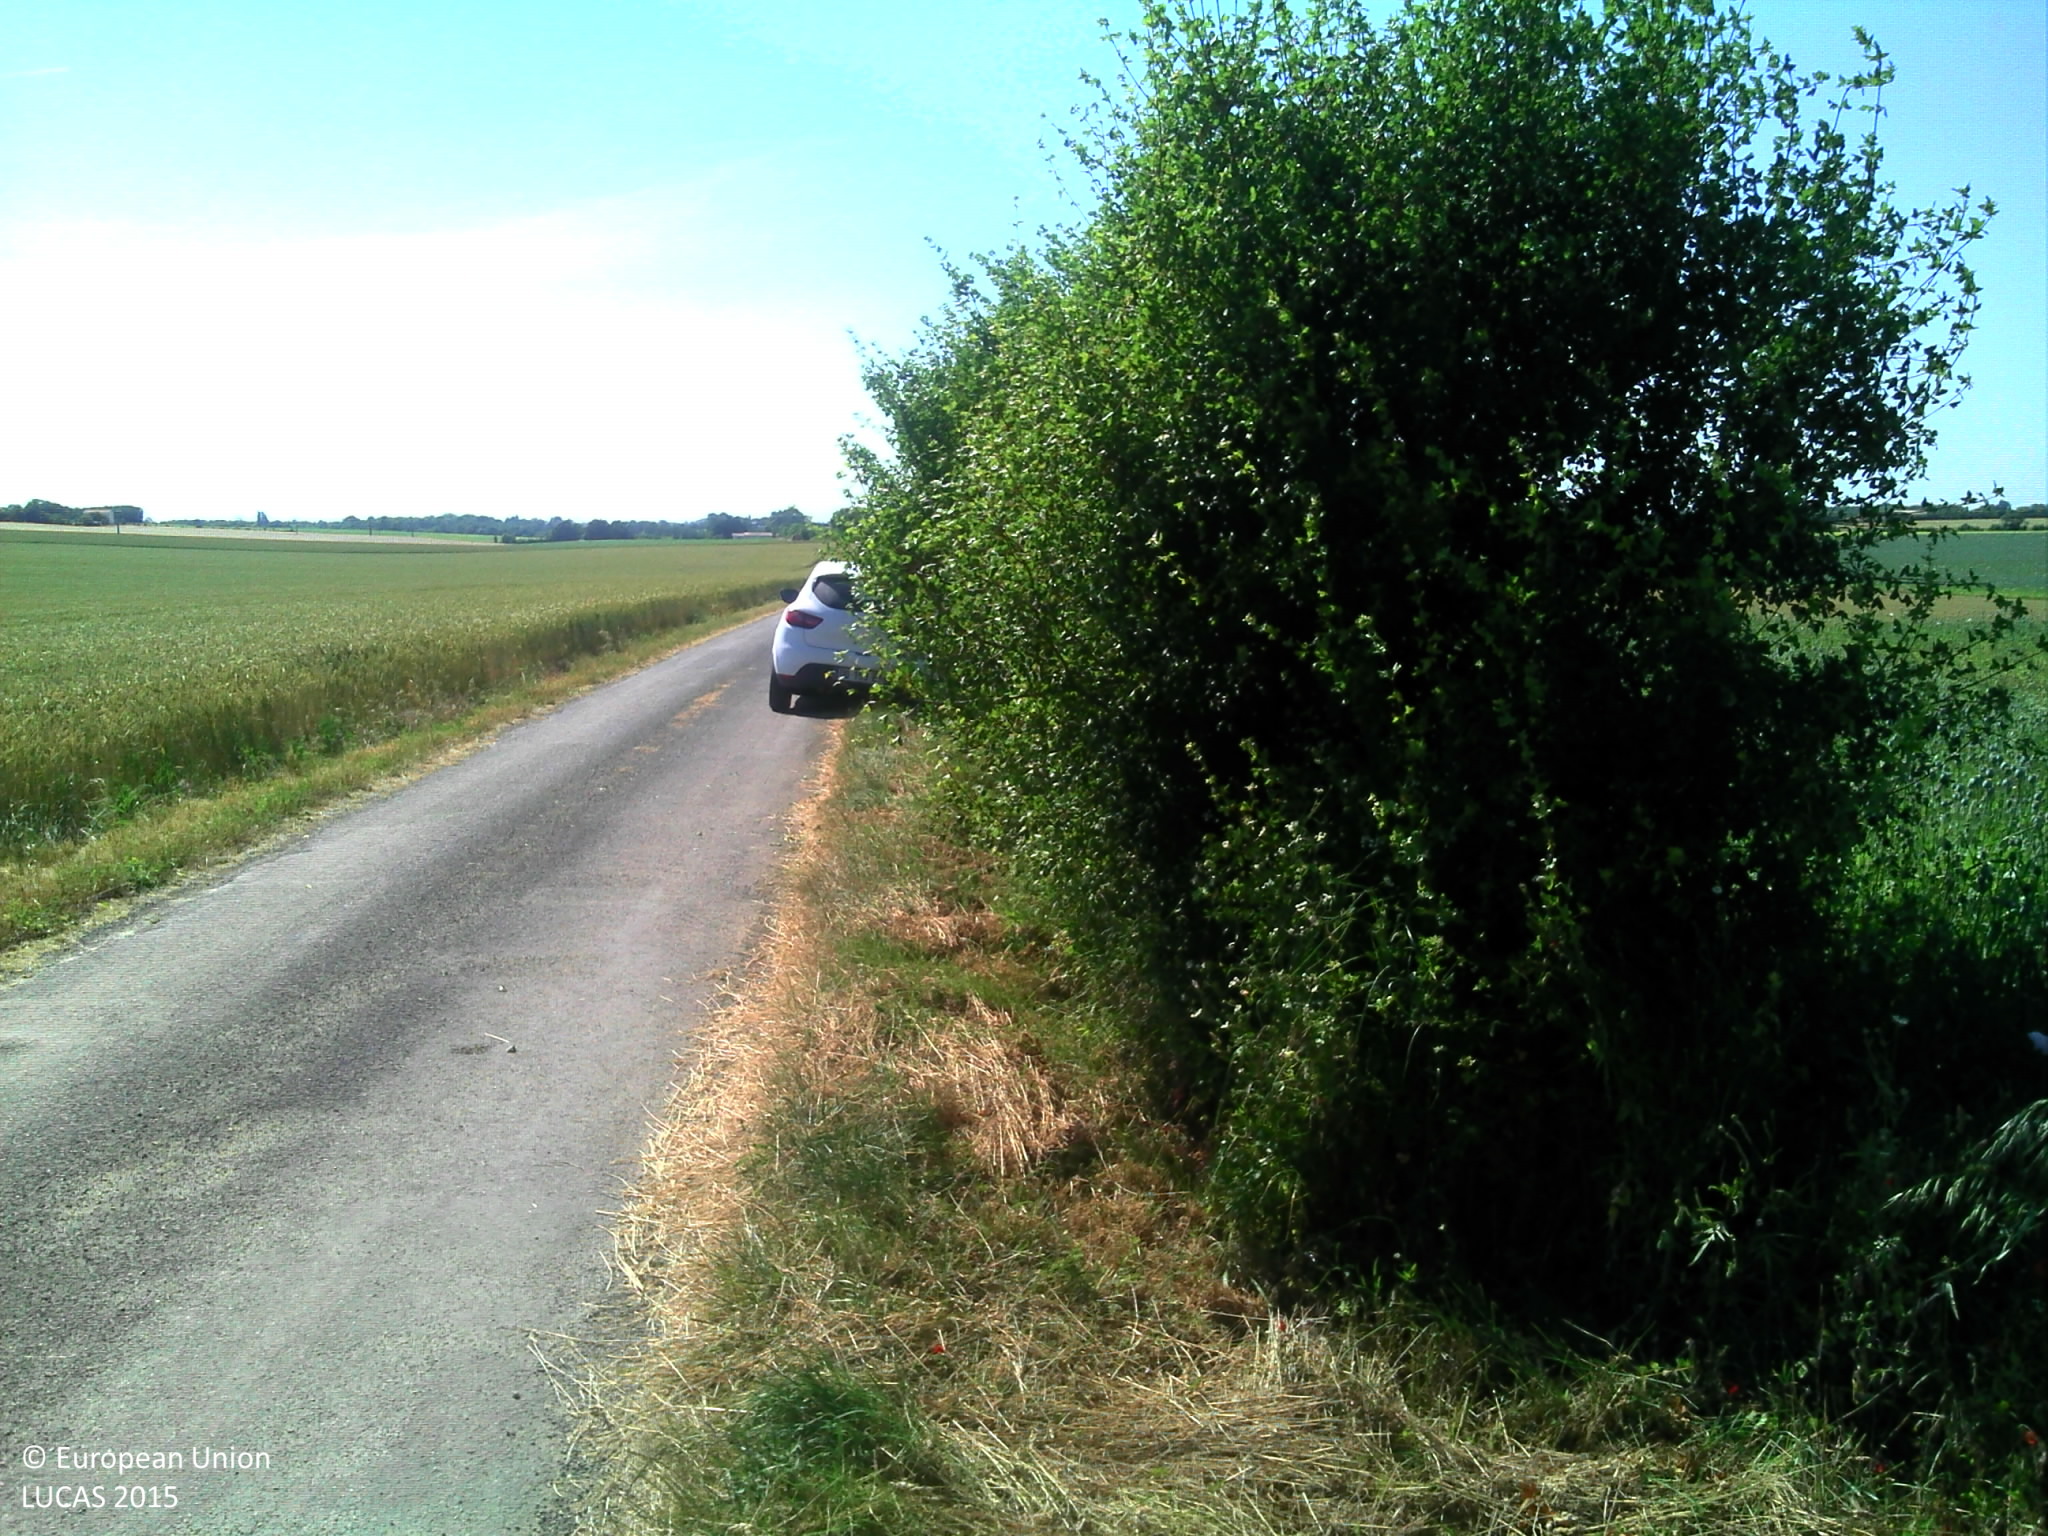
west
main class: Cropland
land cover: Mixed cereals for fodder
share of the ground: > 75 %
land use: Agriculture (excluding fallow land and kitchen gardens)
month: June
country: FR
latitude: 46.0872
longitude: -1.0360
